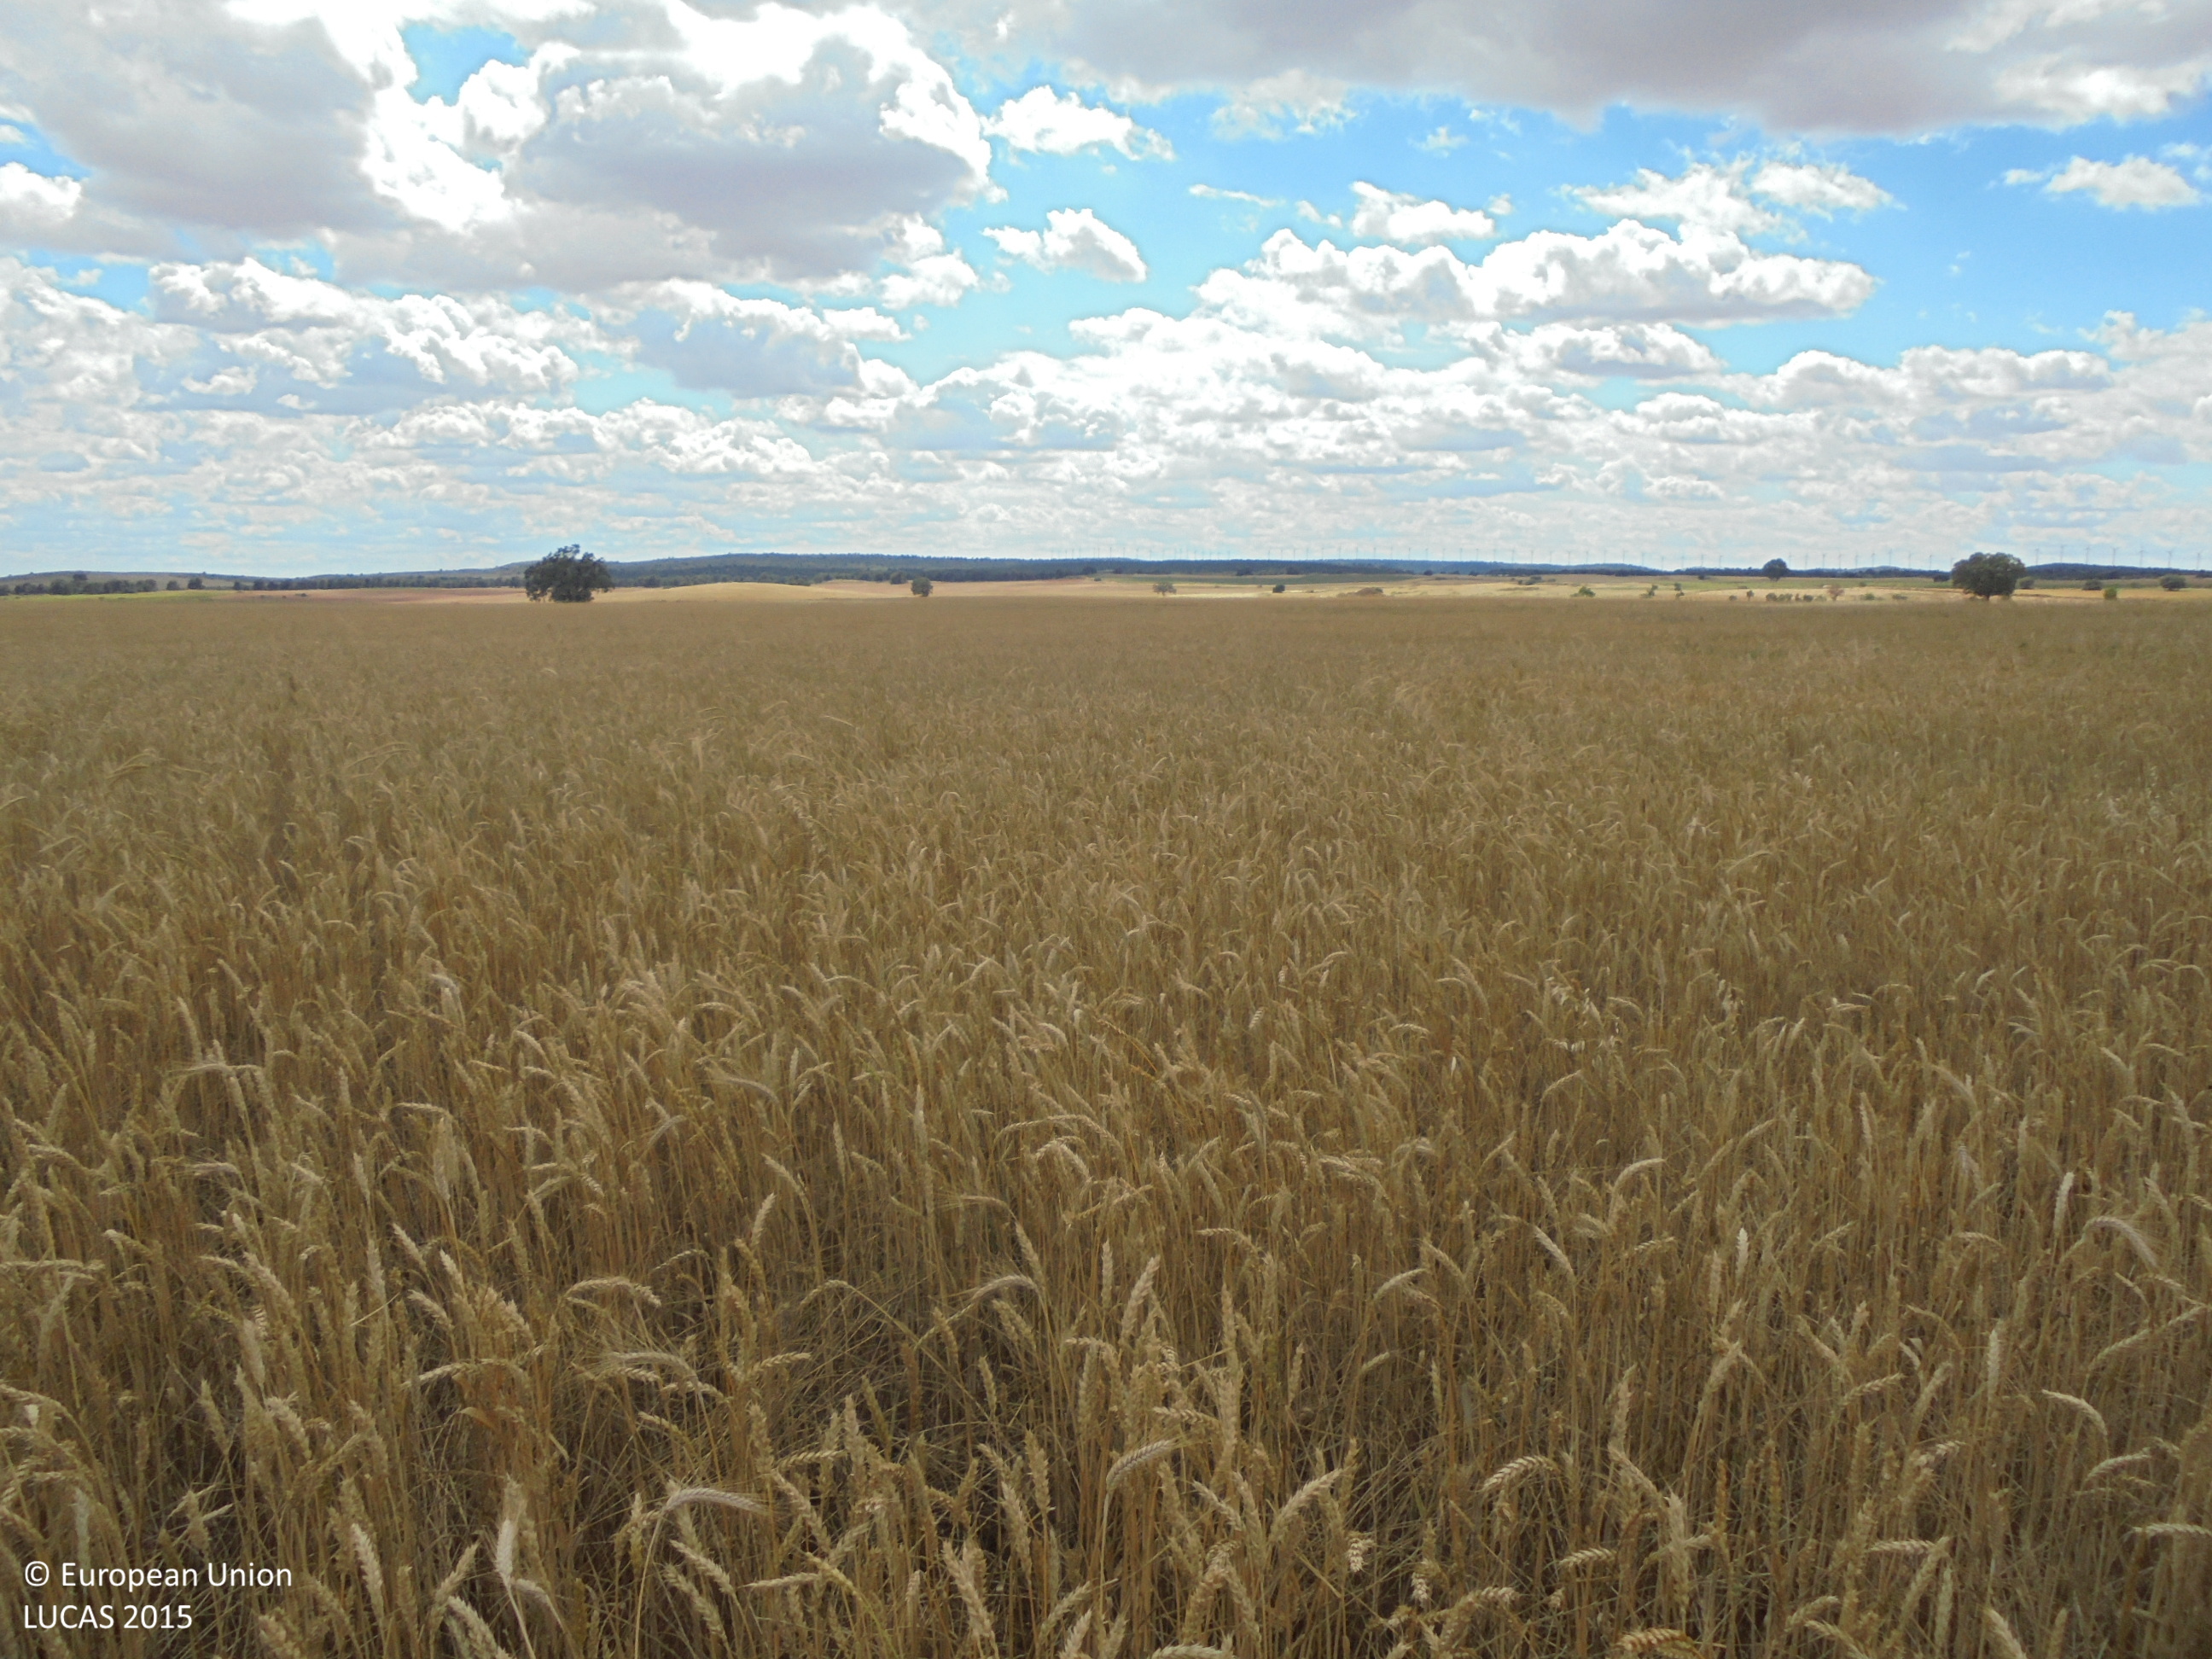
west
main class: Cropland
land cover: Durum wheat
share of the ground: > 75 %
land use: Agriculture (excluding fallow land and kitchen gardens)
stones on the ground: < 10 %
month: June
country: ES
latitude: 38.7578
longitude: -1.4217
